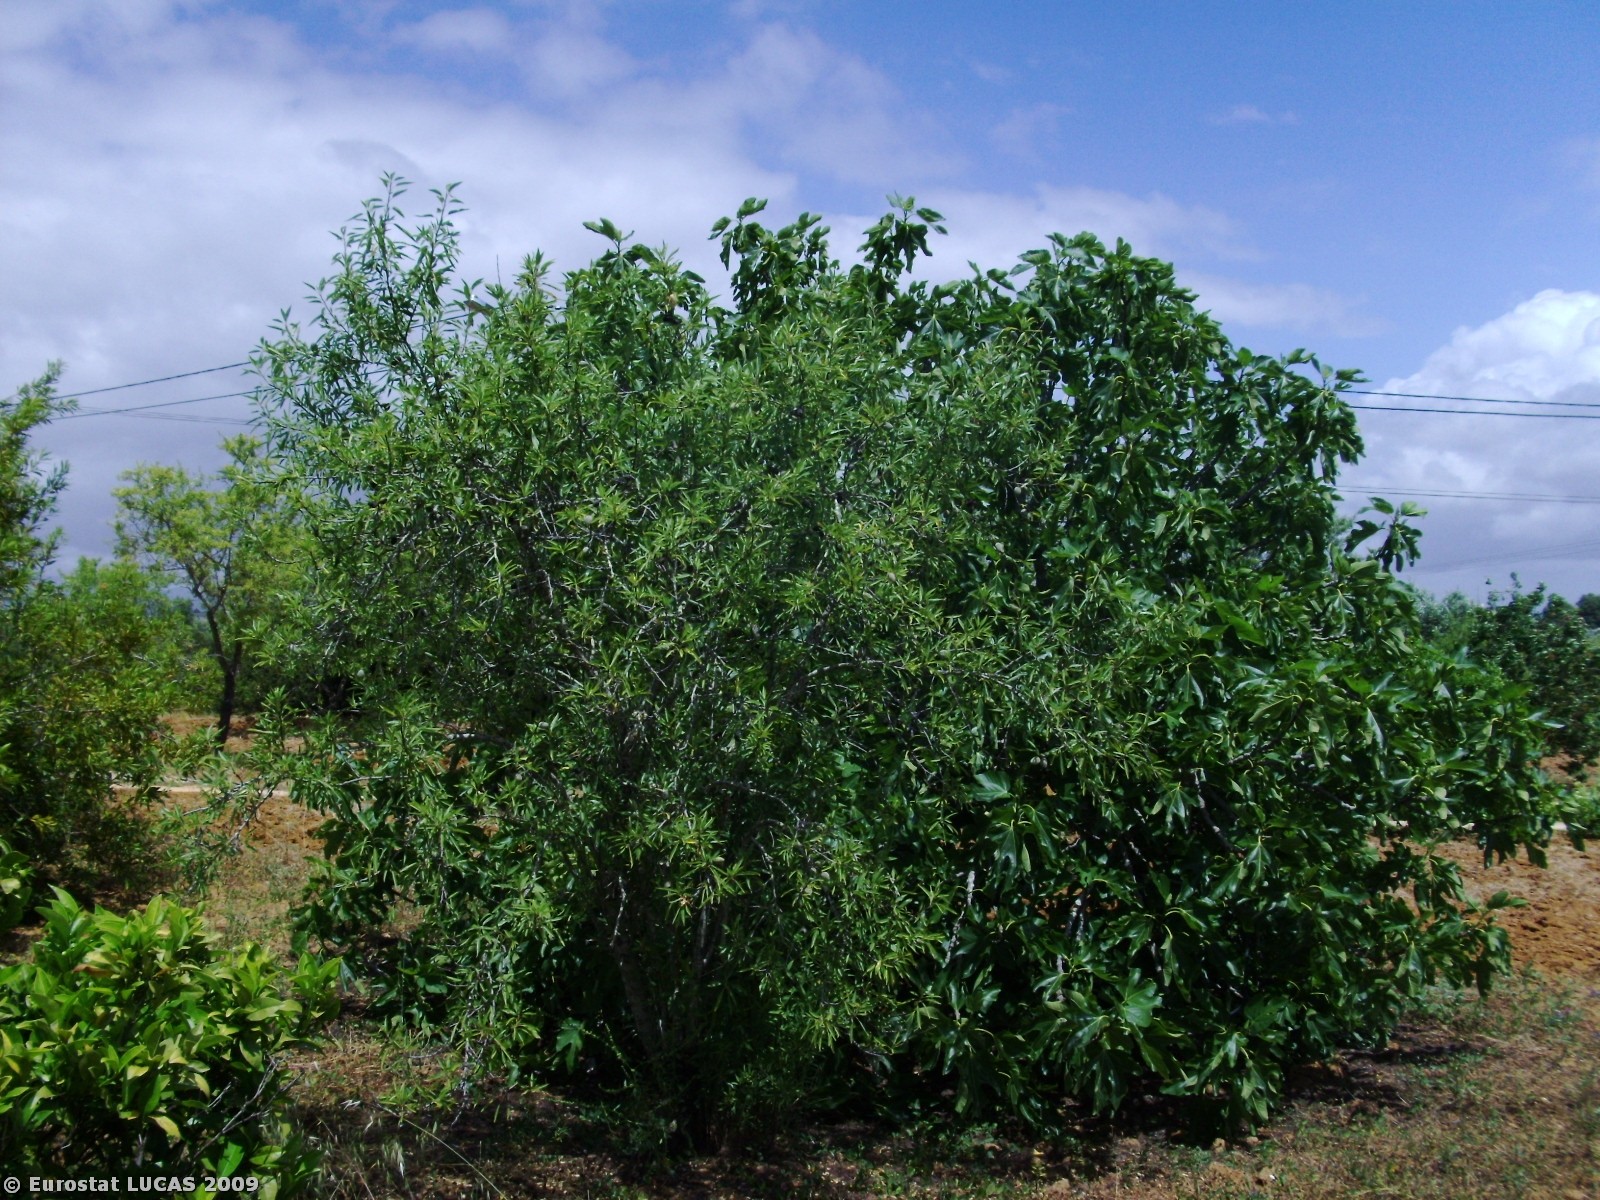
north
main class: Cropland
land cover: Permanent industrial crops
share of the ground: 10 - 25 %
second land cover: Spontaneously vegetated surfaces
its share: 50 - 75 %
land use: Agriculture (excluding fallow land and kitchen gardens)
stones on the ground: 10 - 25 %
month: May
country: PT
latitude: 37.1082
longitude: -8.4667
